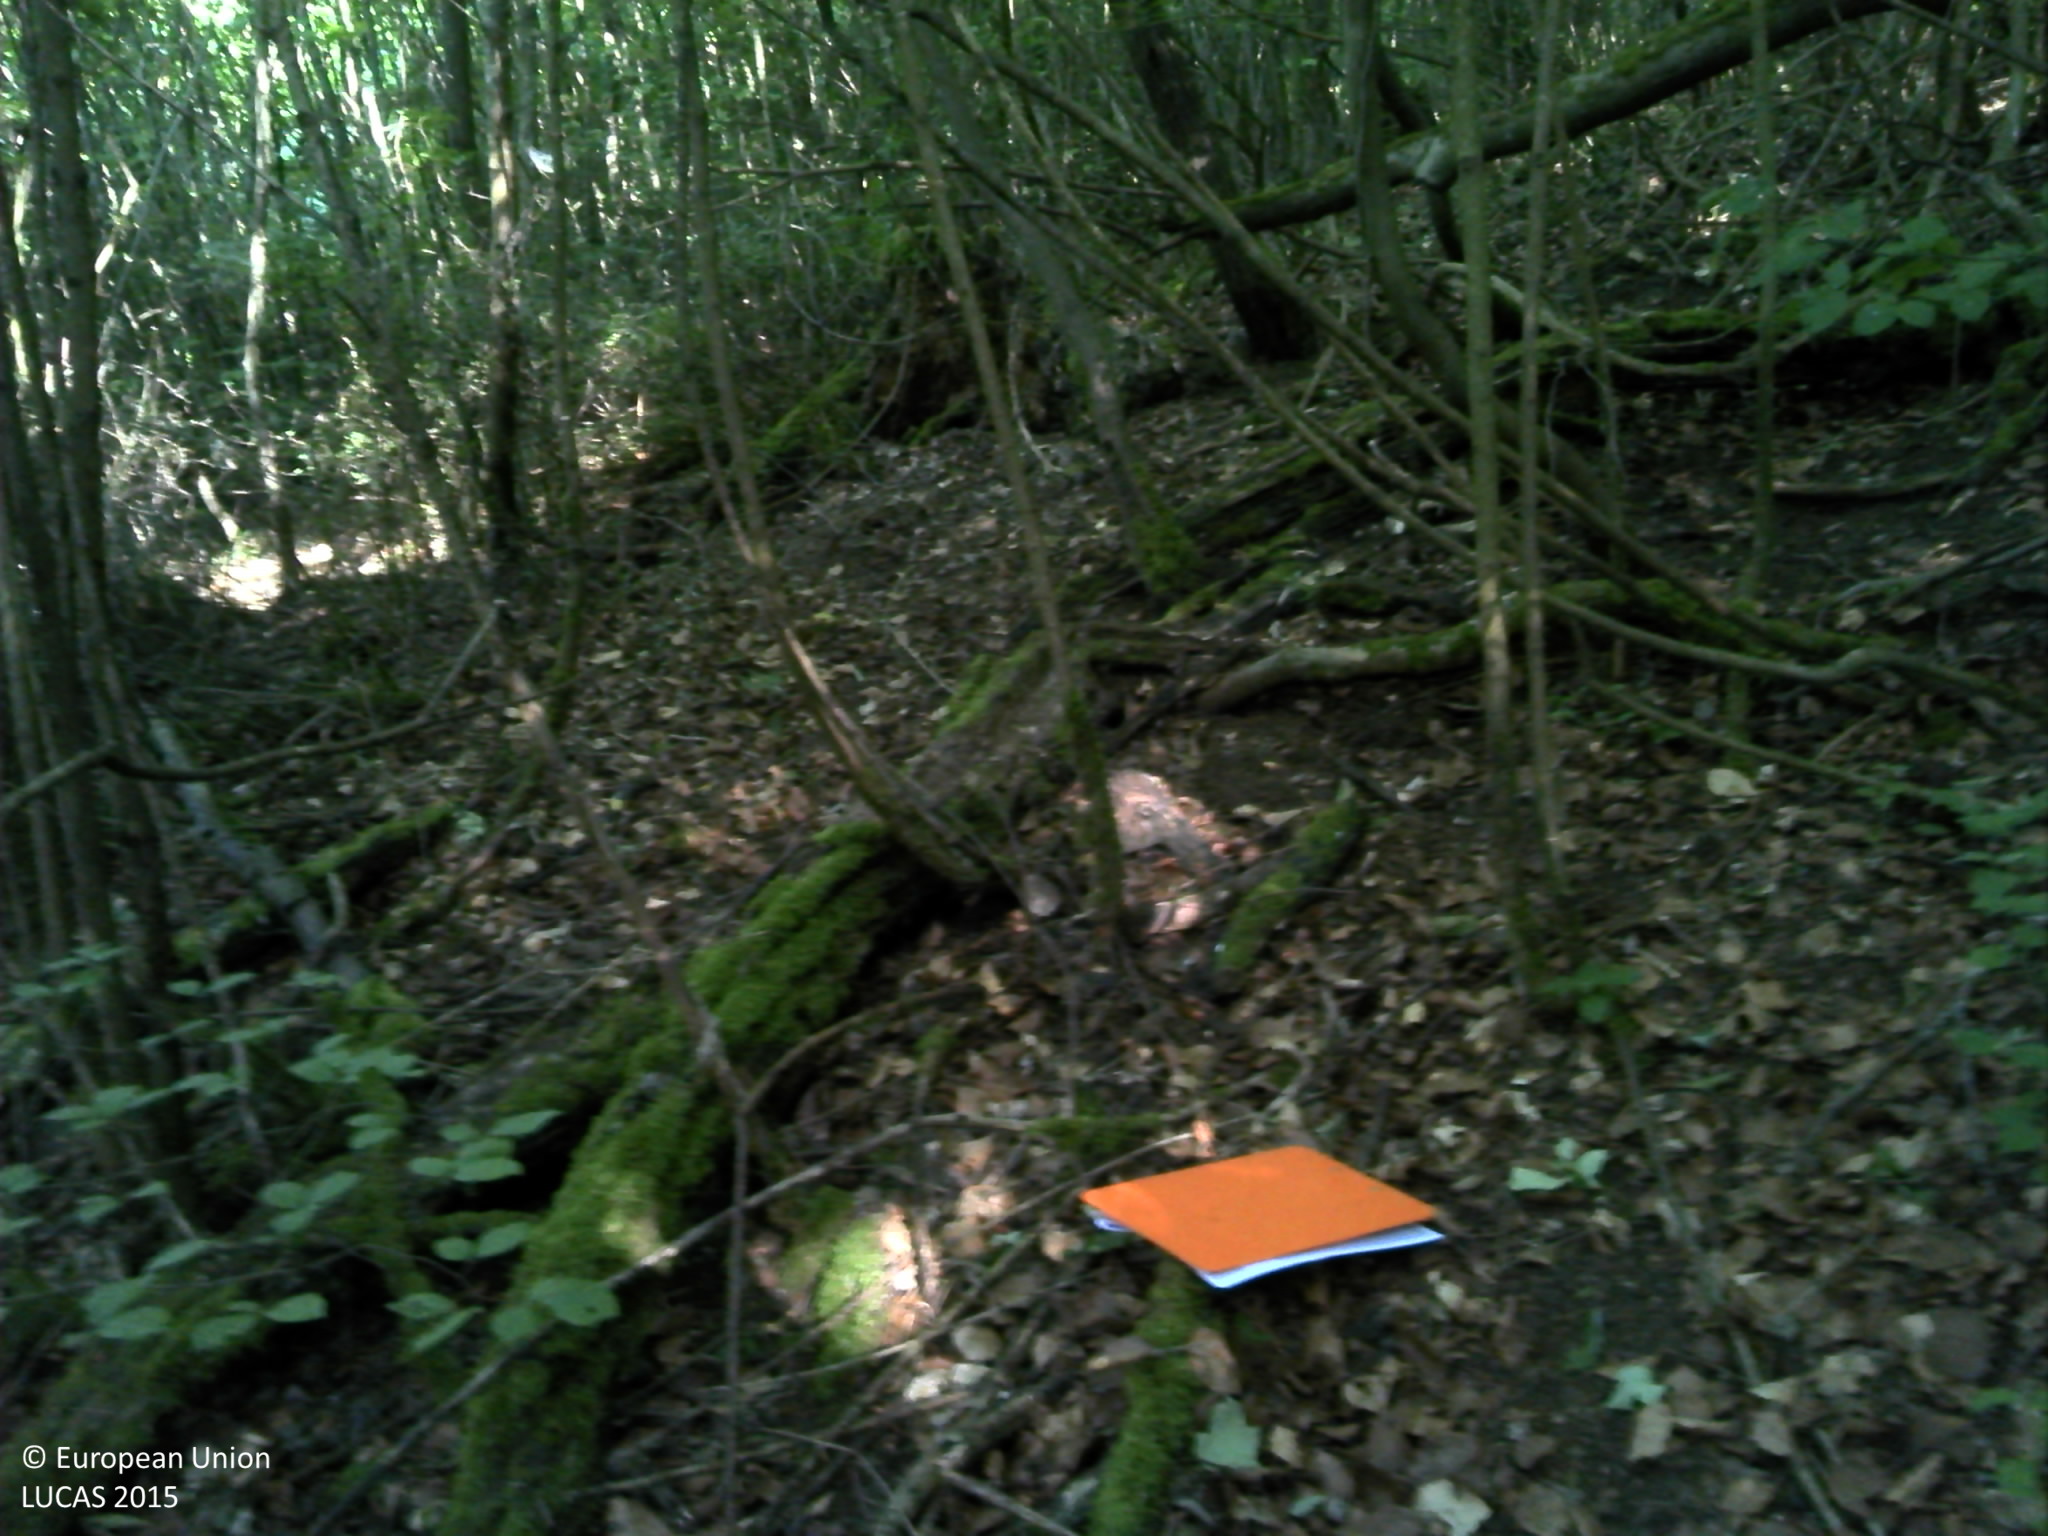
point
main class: Woodland
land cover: Broadleaved woodland
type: beech forest
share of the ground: > 75 %
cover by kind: broadleaved forest trees 100 %
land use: Forestry
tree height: > 5 m
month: June
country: FR
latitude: 49.2168
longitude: 6.0869
